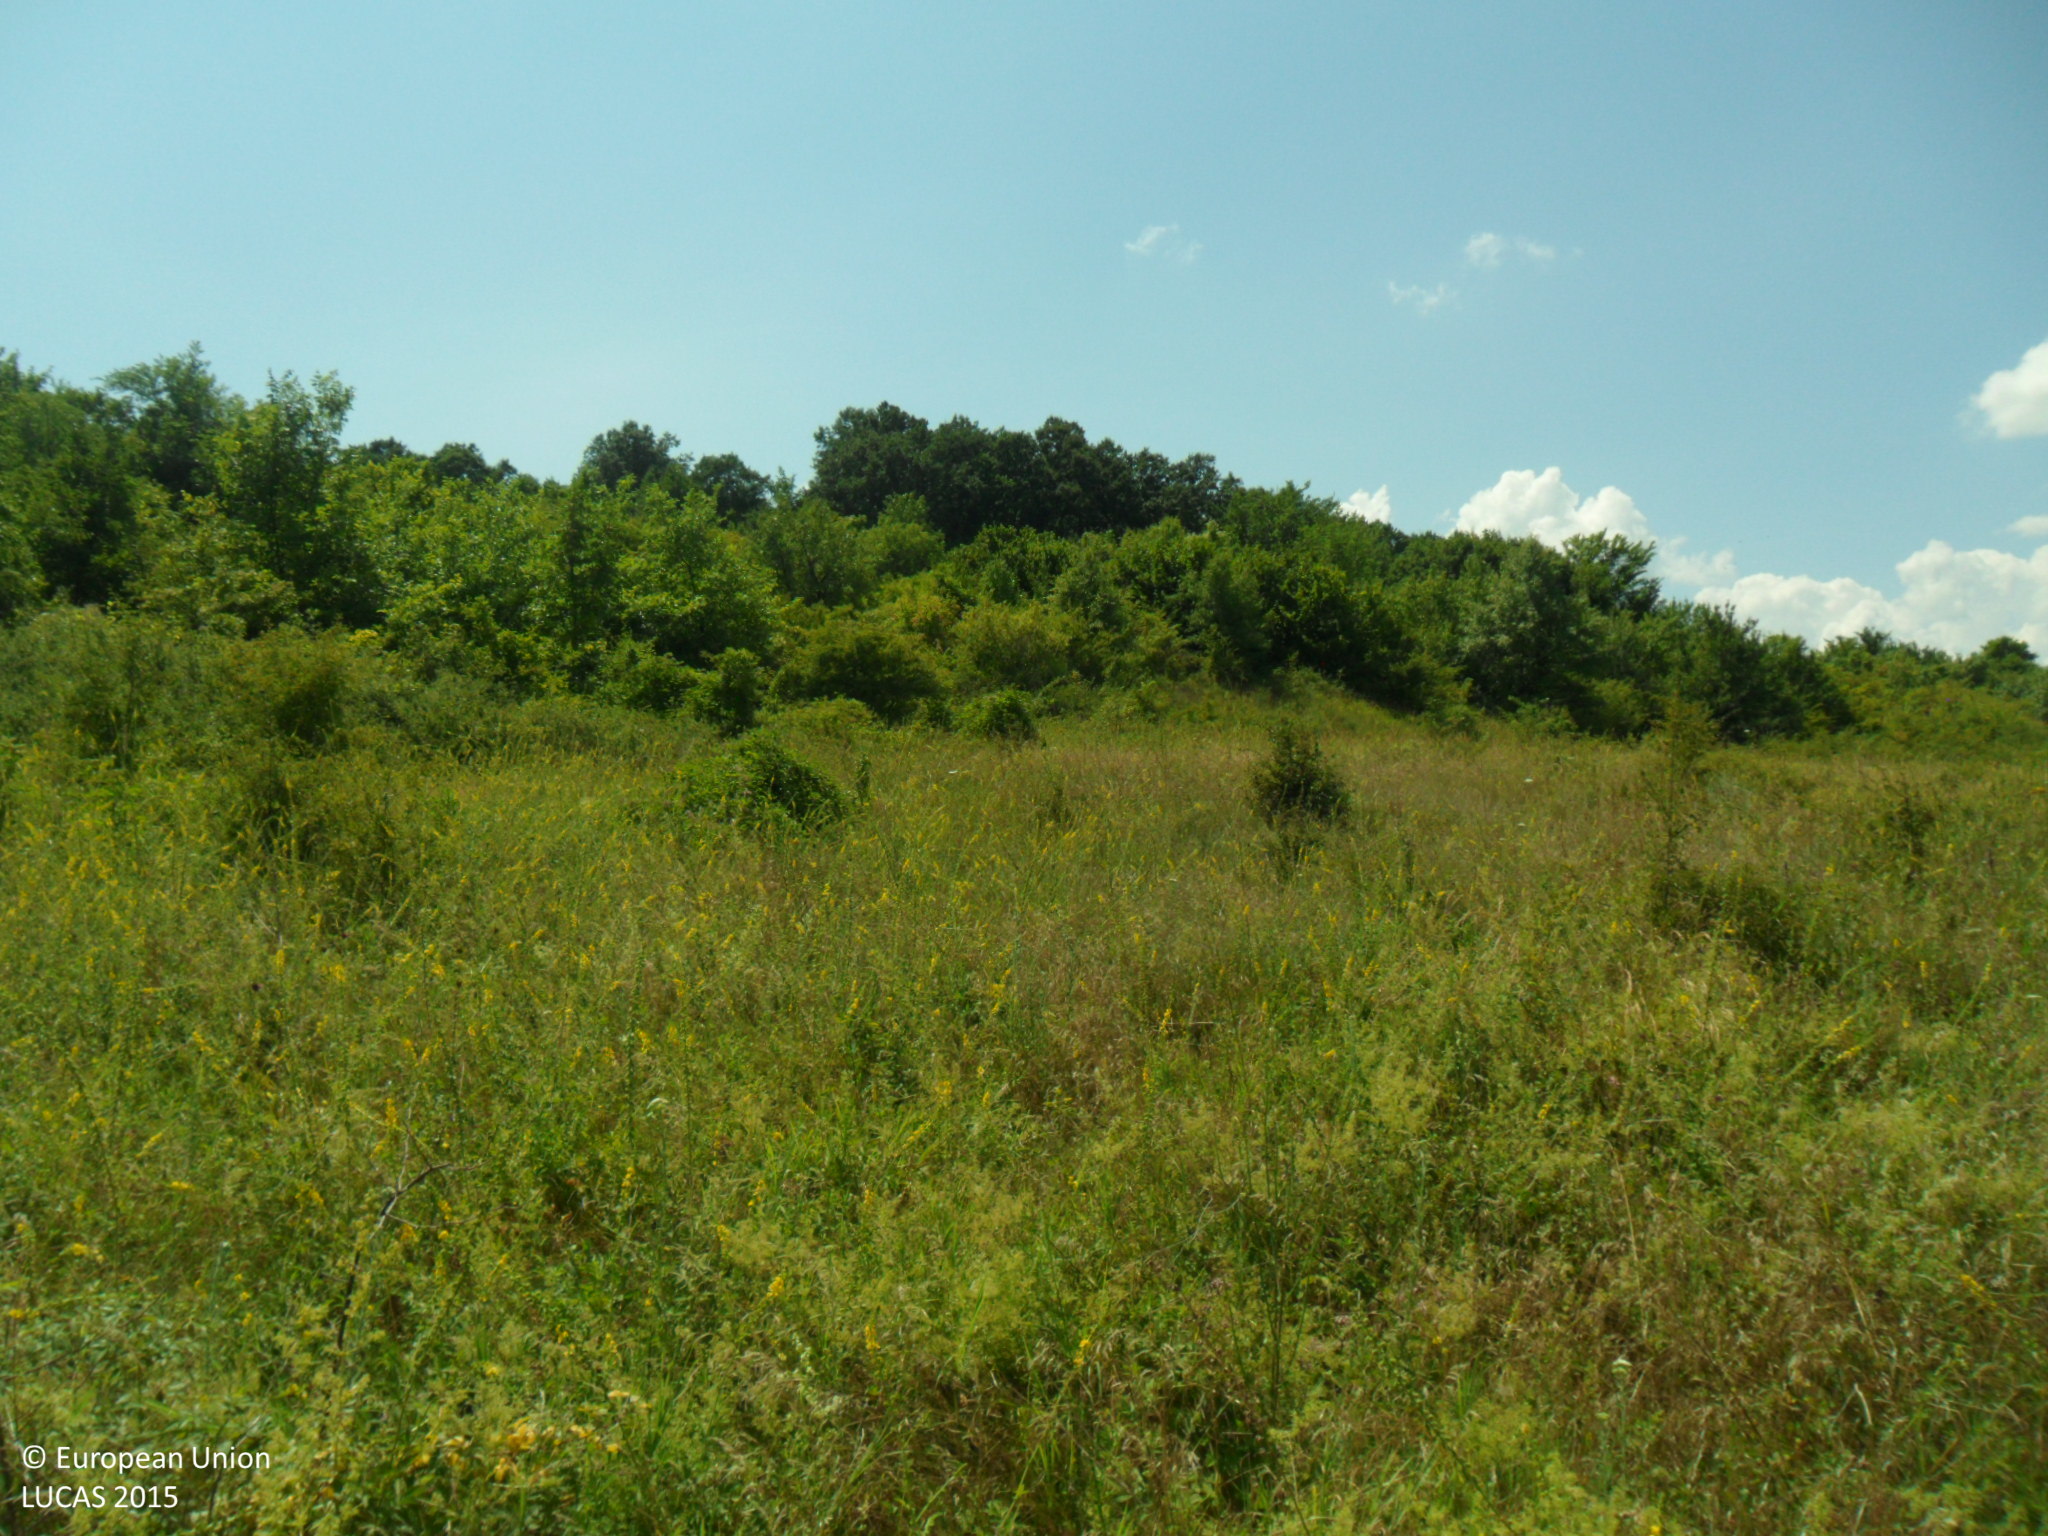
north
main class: Woodland
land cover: Broadleaved woodland
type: mesophytic deciduous forest
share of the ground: > 75 %
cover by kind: broadleaved forest trees 80 %, shrubs 15 %, herbaceous plants 5 %
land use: Forestry
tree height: < 5 m
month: July
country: BG
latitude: 43.0687
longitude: 26.9723
